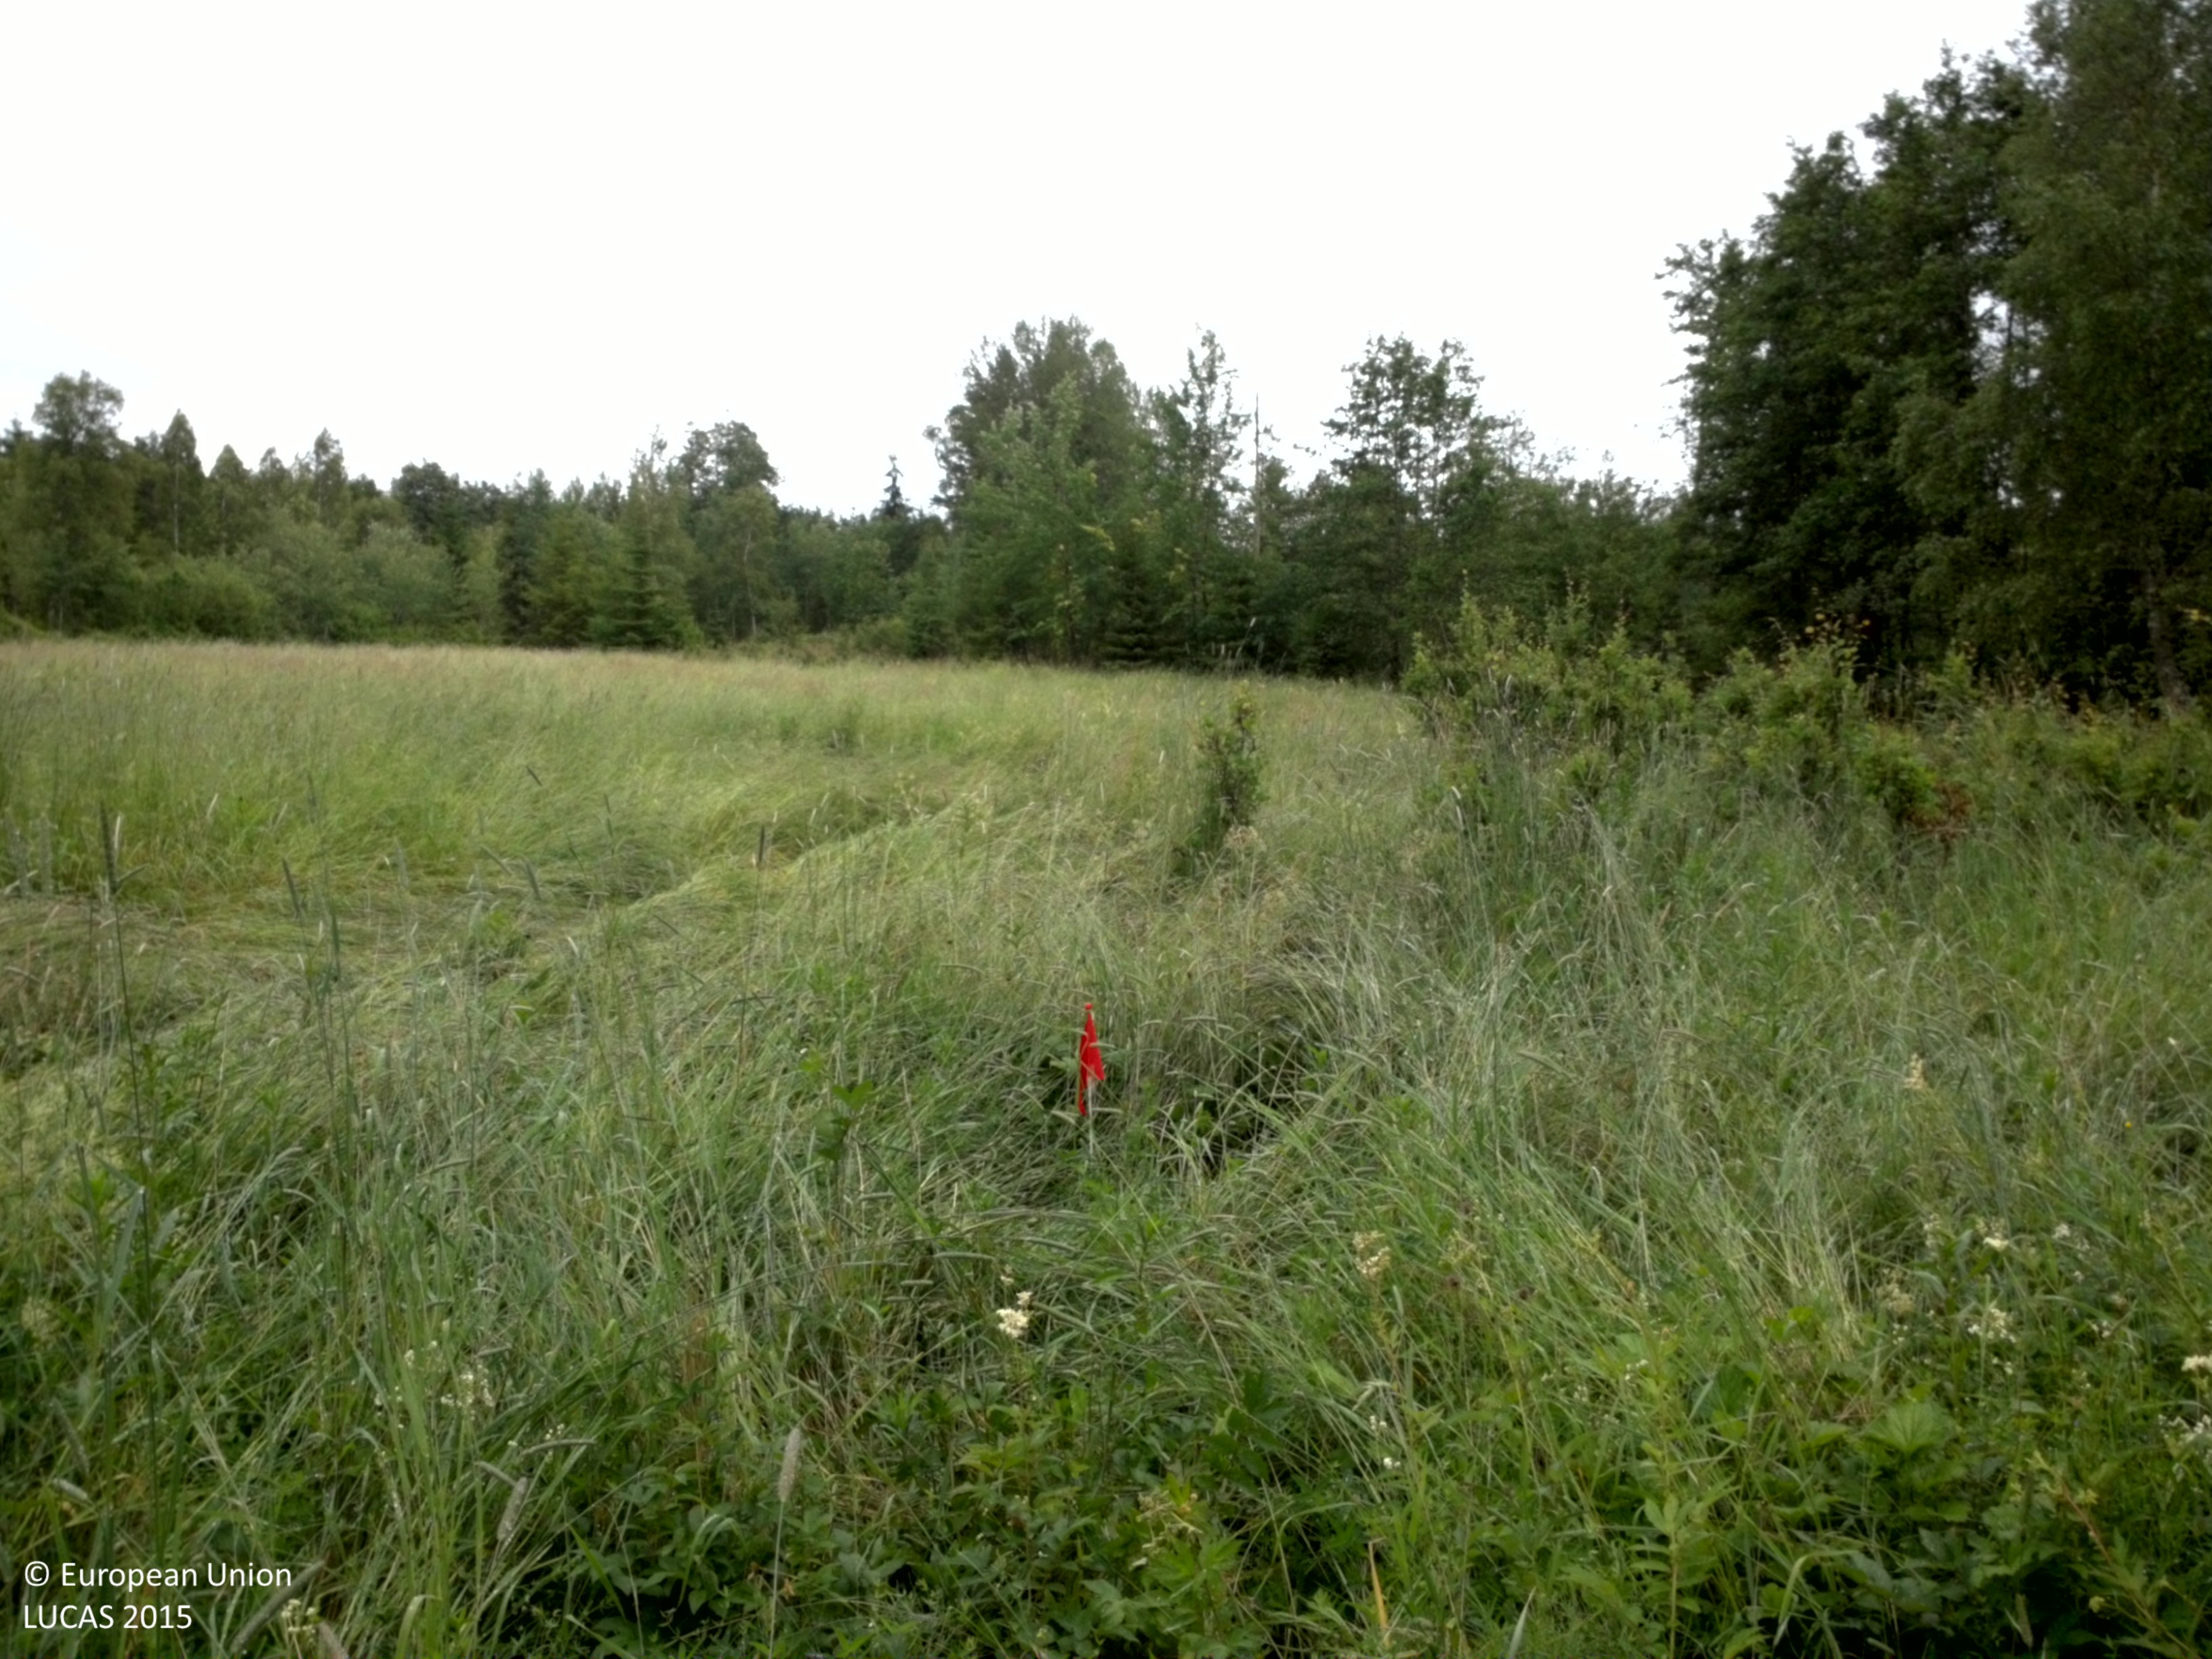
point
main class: Grassland
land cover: Grassland without tree/shrub cover
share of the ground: > 75 %
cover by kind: herbaceous plants 100 %
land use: Agriculture (excluding fallow land and kitchen gardens)
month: July
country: SE
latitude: 58.5194
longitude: 14.0282
